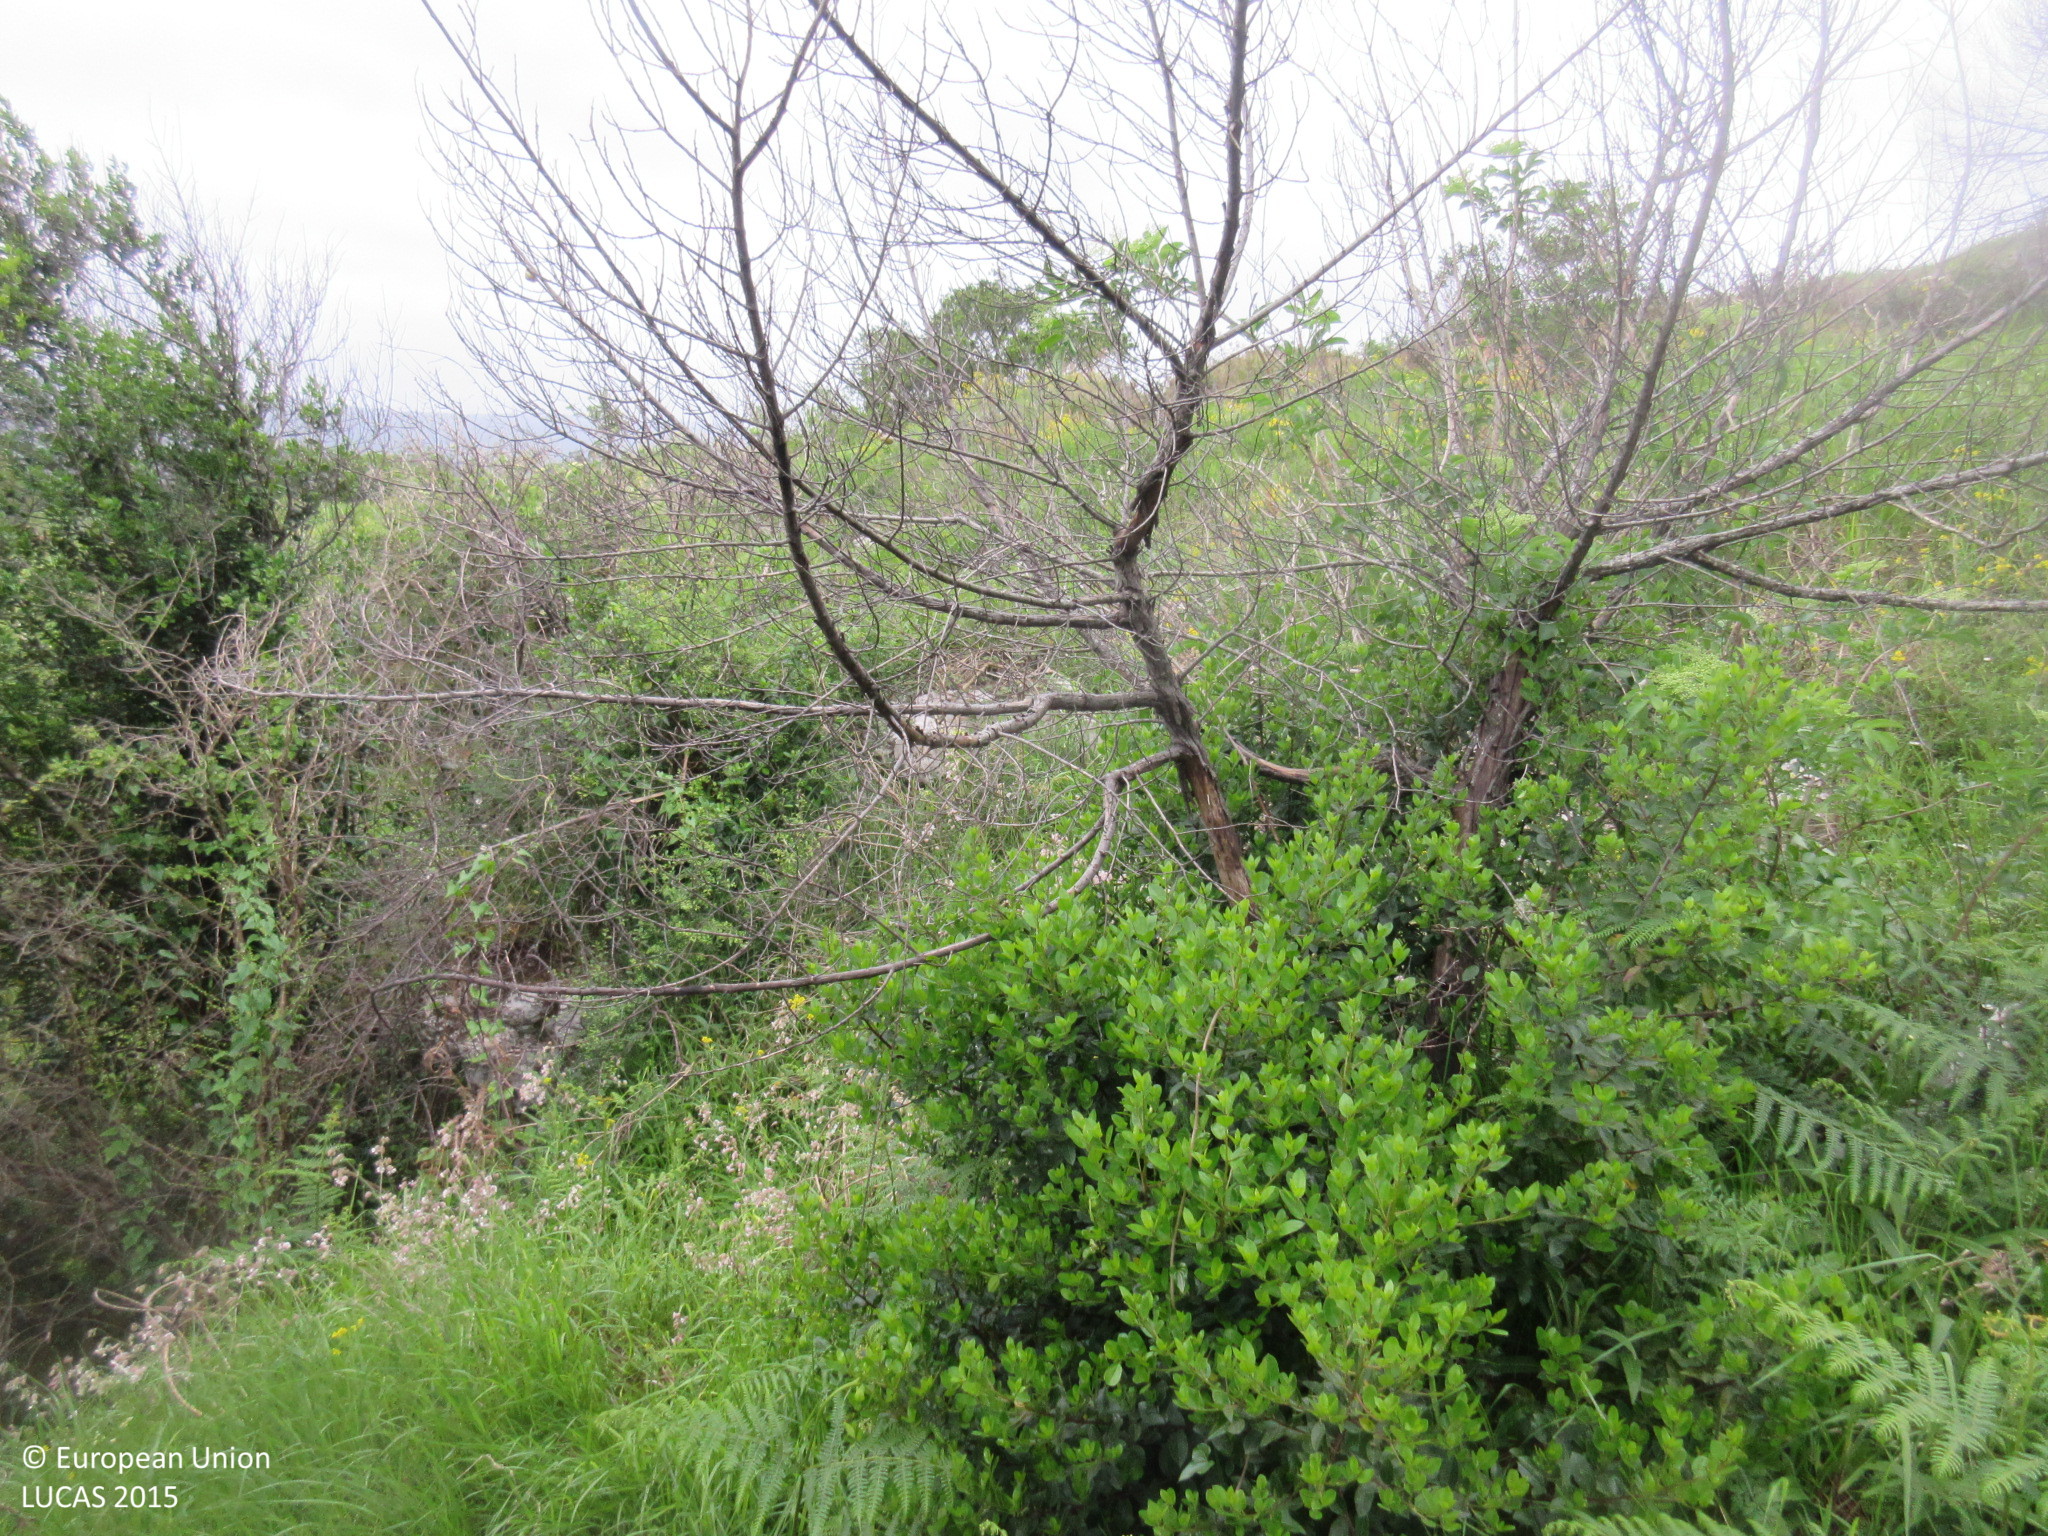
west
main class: Grassland
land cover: Grassland with sparse tree/shrub cover
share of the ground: > 75 %
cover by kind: herbaceous plants 90 %, broadleaved forest trees 5 %, shrubs 5 %
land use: Forestry
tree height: > 5 m
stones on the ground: < 10 %
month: May
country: ES
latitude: 43.3424
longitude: -4.2537
